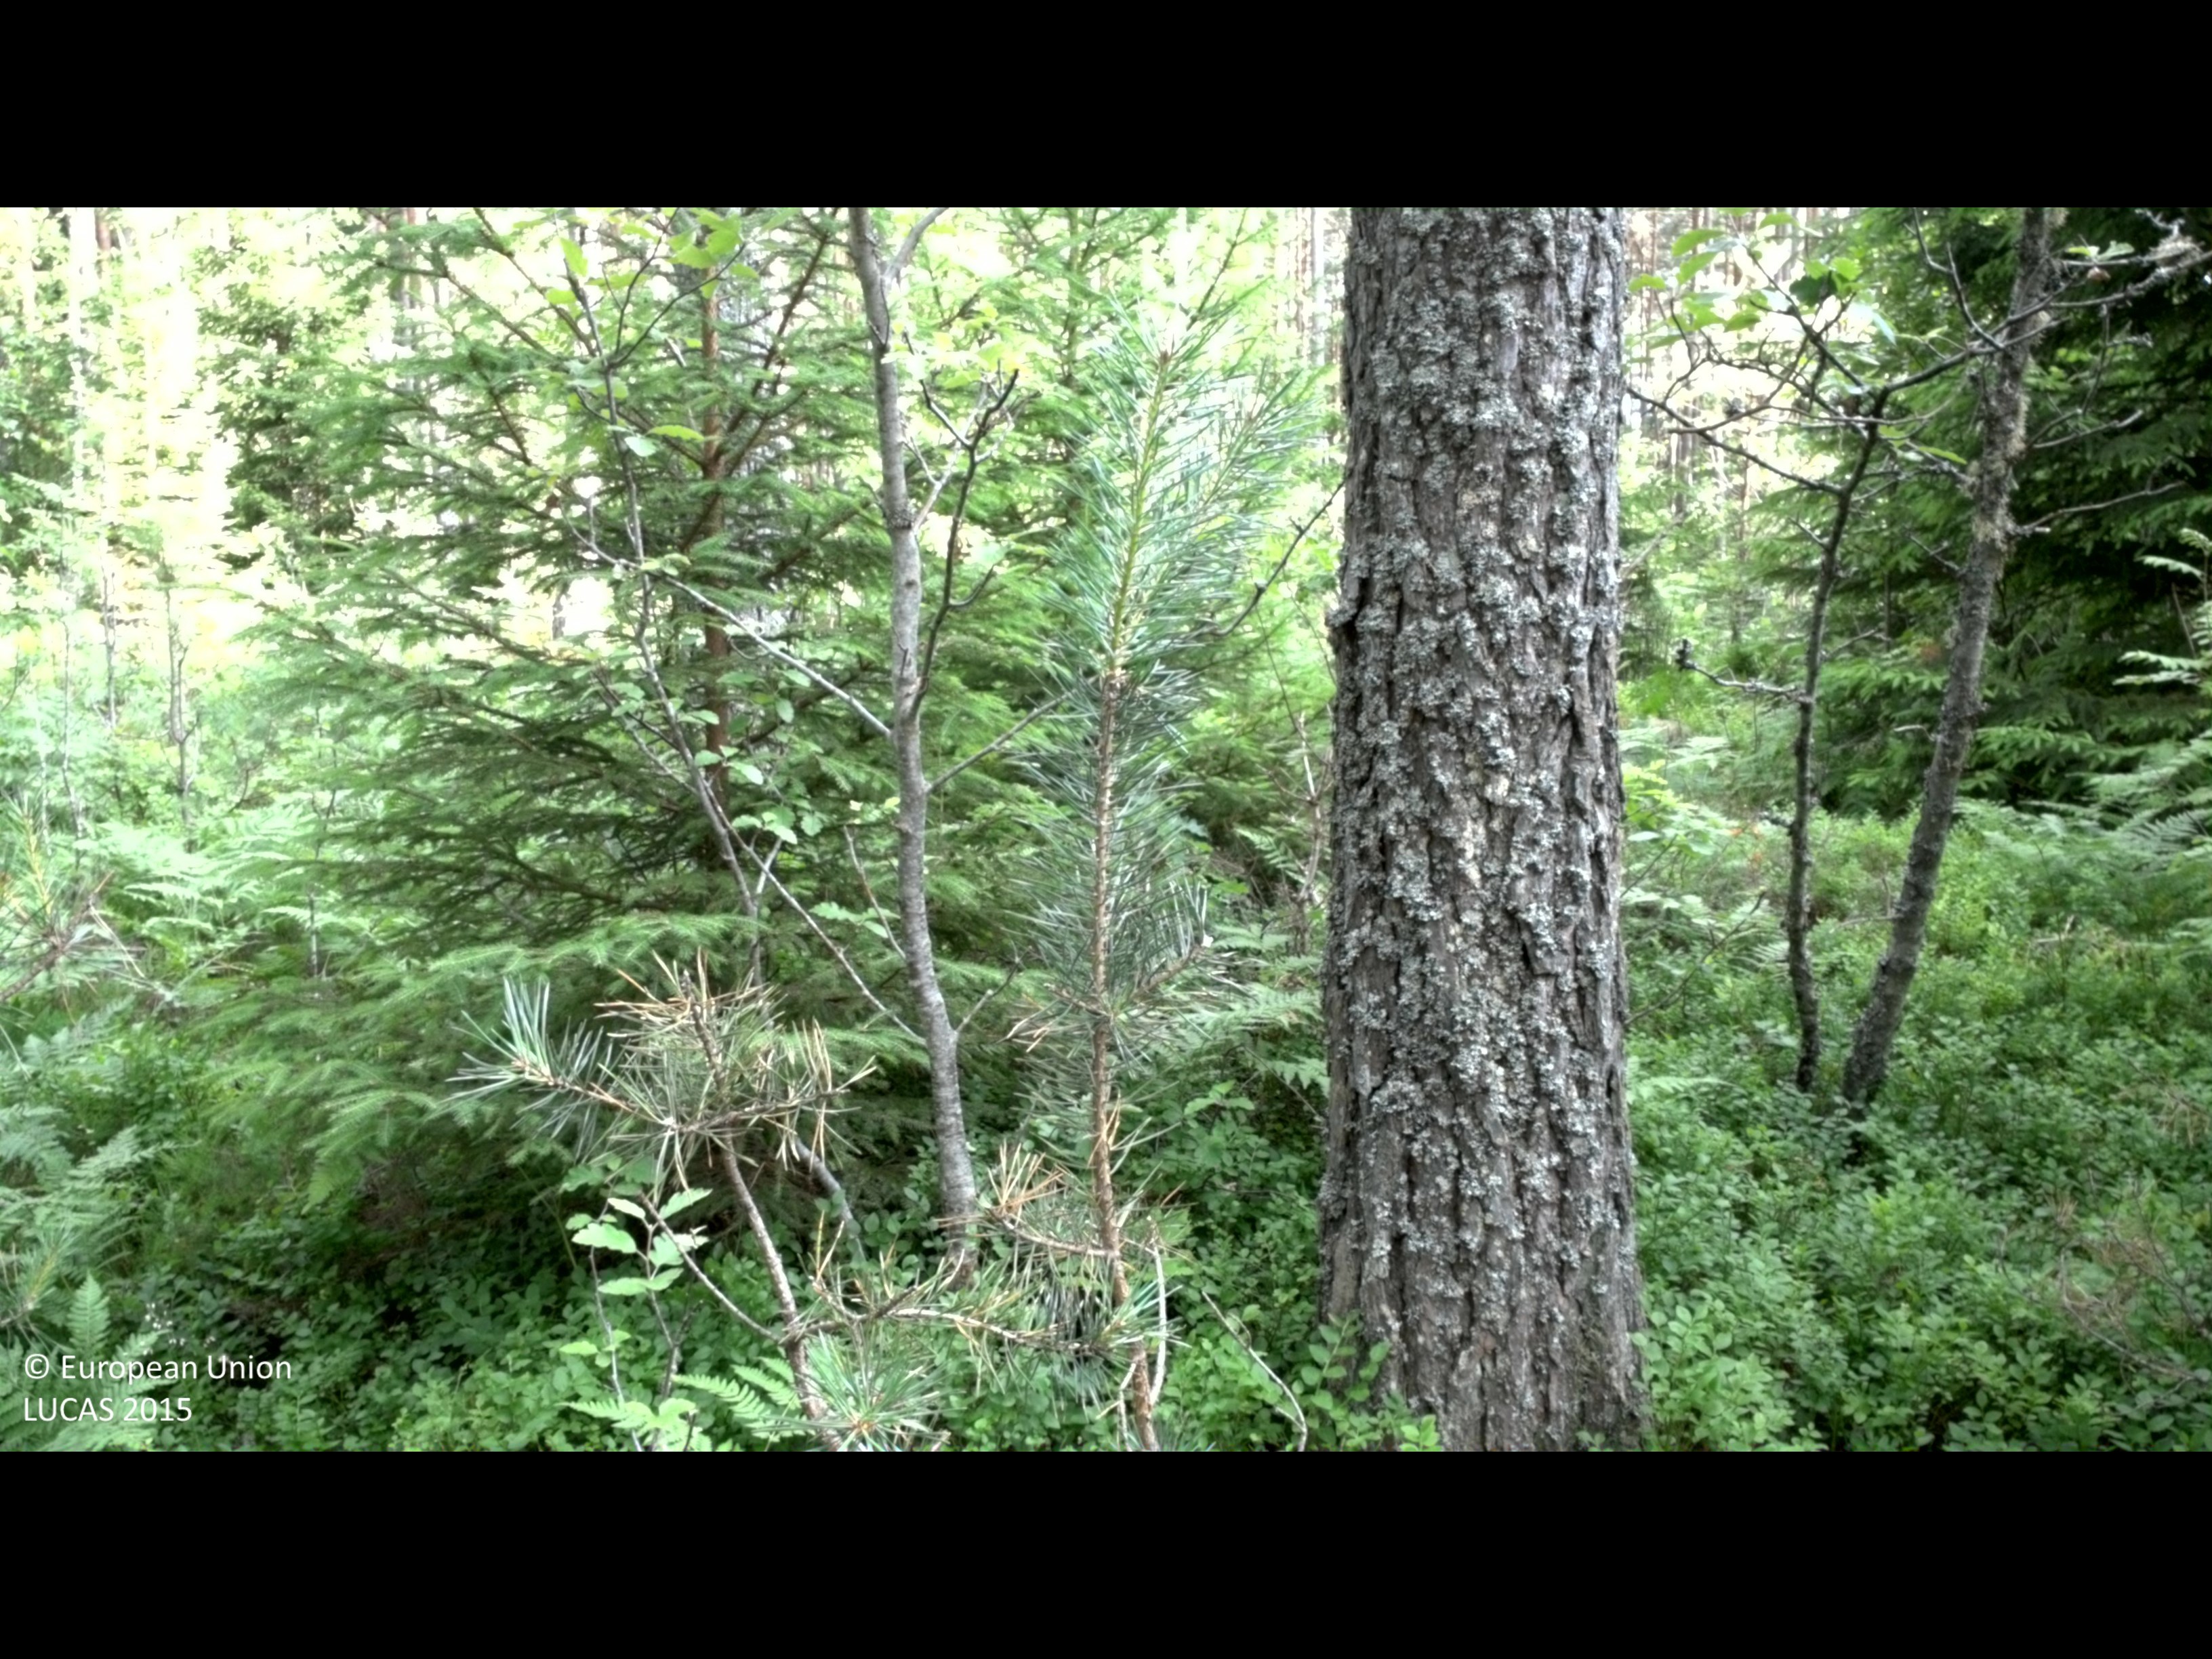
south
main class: Woodland
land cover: Pine dominated mixed woodland
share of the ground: 50 - 75 %
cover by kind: coniferous forest trees 45 %, shrubs 35 %, broadleaved forest trees 15 %, herbaceous plants 5 %
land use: Forestry
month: July
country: SE
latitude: 57.9012
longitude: 16.0880
